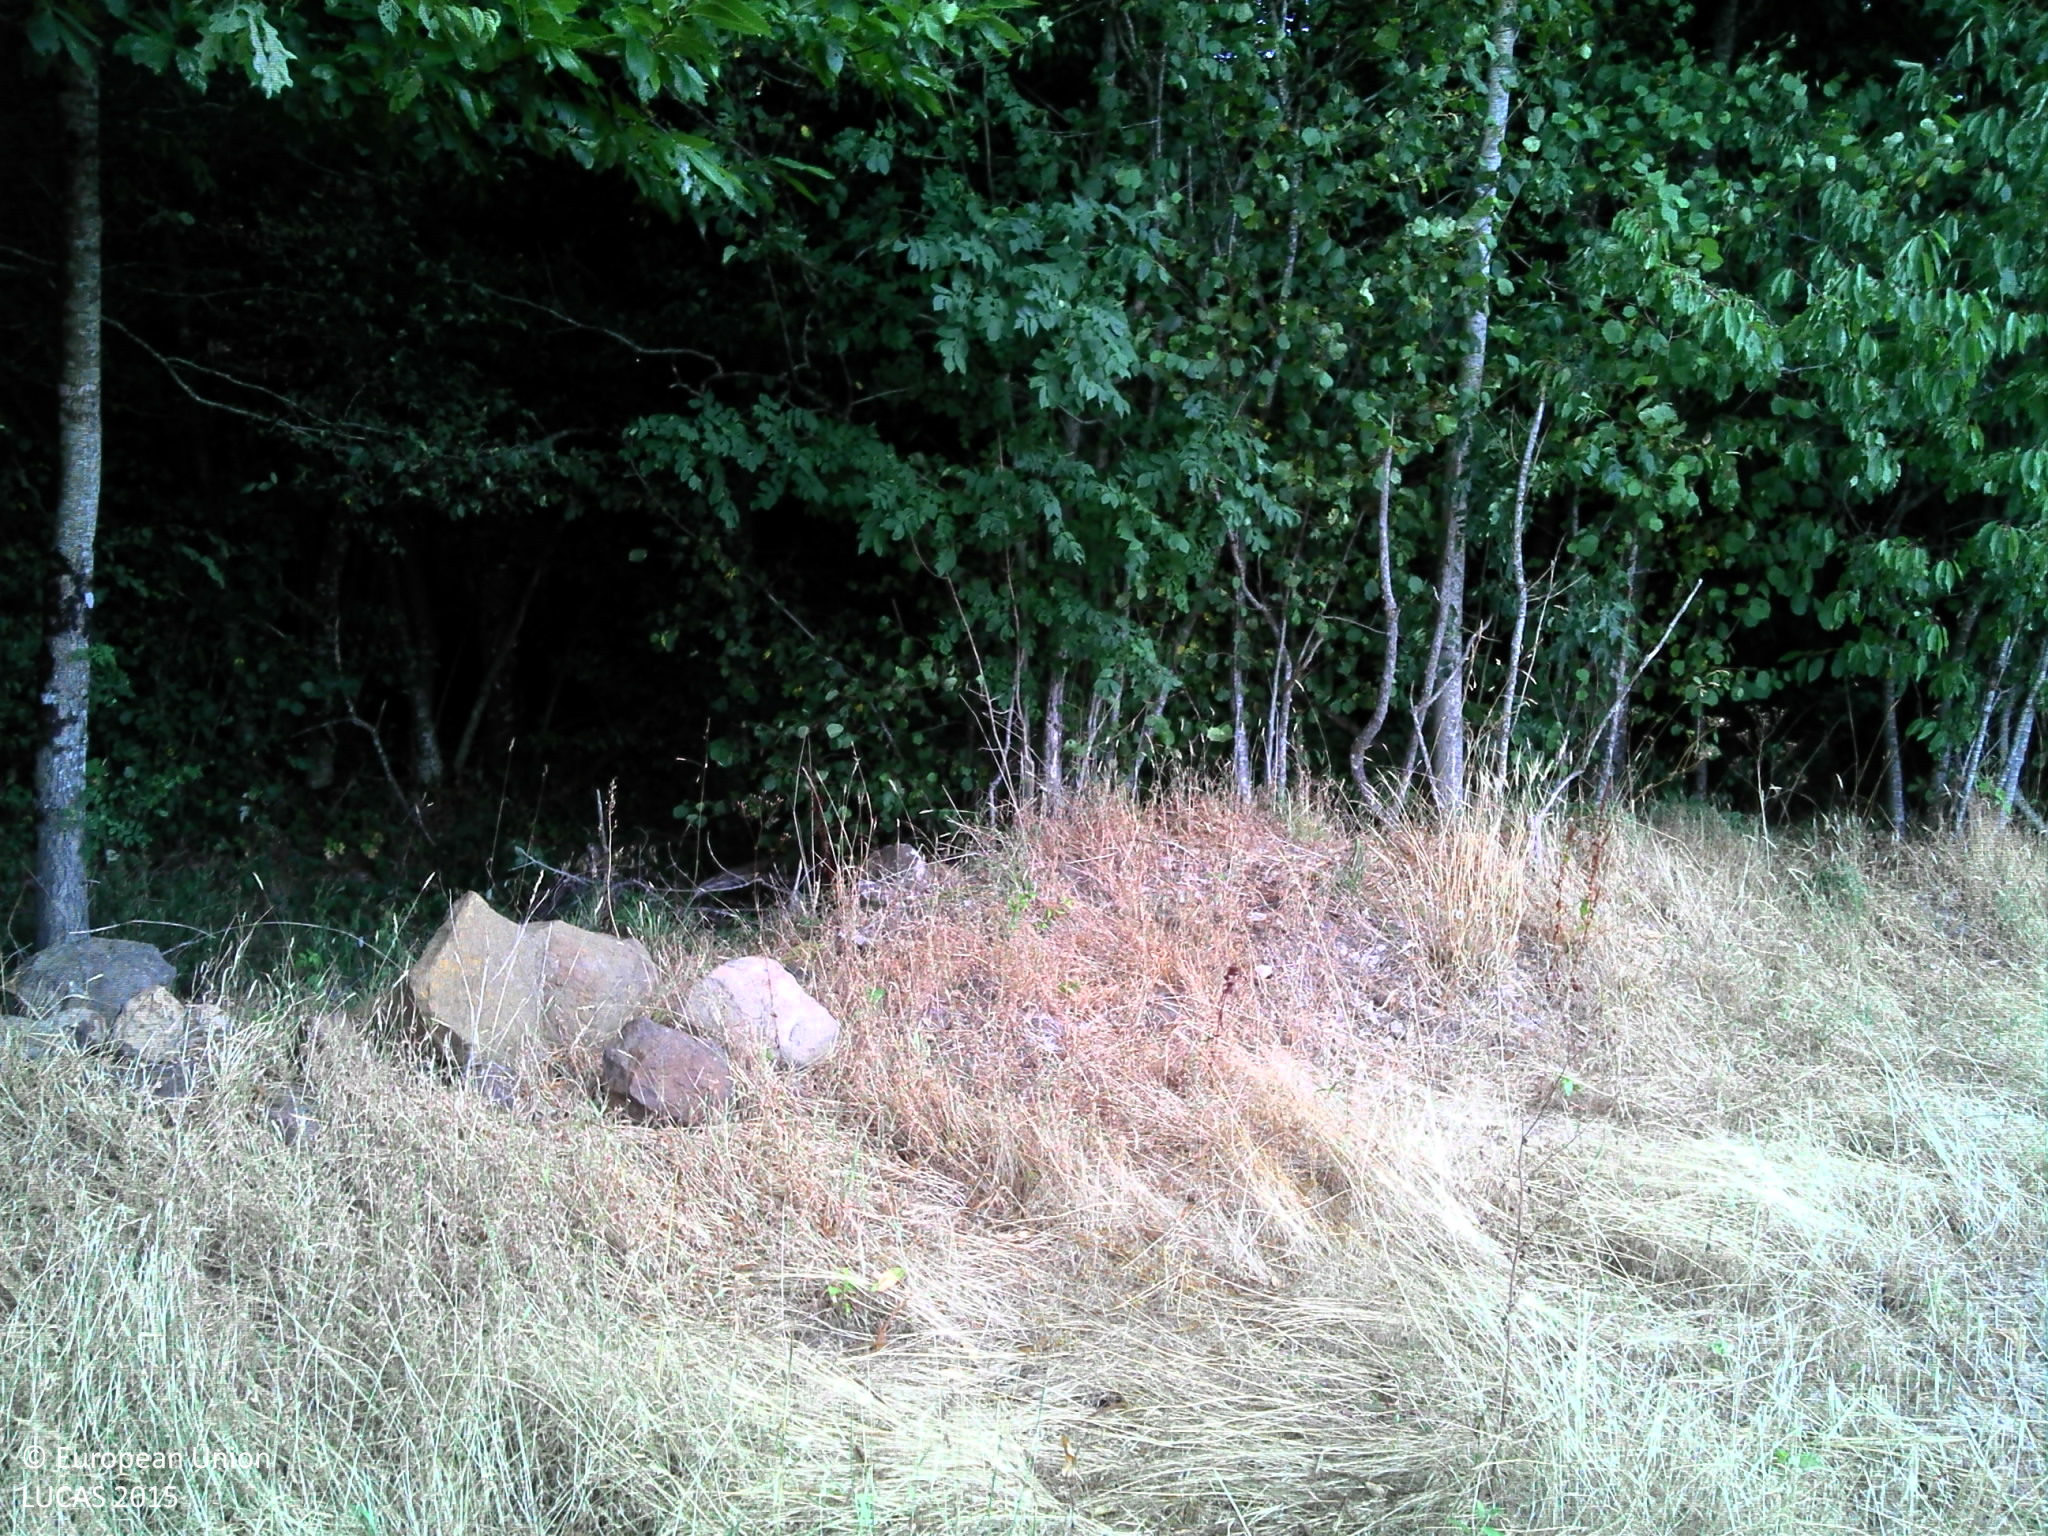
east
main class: Grassland
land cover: Spontaneously vegetated surfaces
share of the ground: > 75 %
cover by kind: herbaceous plants 100 %
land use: Fallow land
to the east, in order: Spontaneously vegetated surfaces; Broadleaved woodland; Tracks; Broadleaved woodland; Tracks; Lines of trees; Fences; Grassland without tree/shrub cover
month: July
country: FR
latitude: 47.5785
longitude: 3.1744
